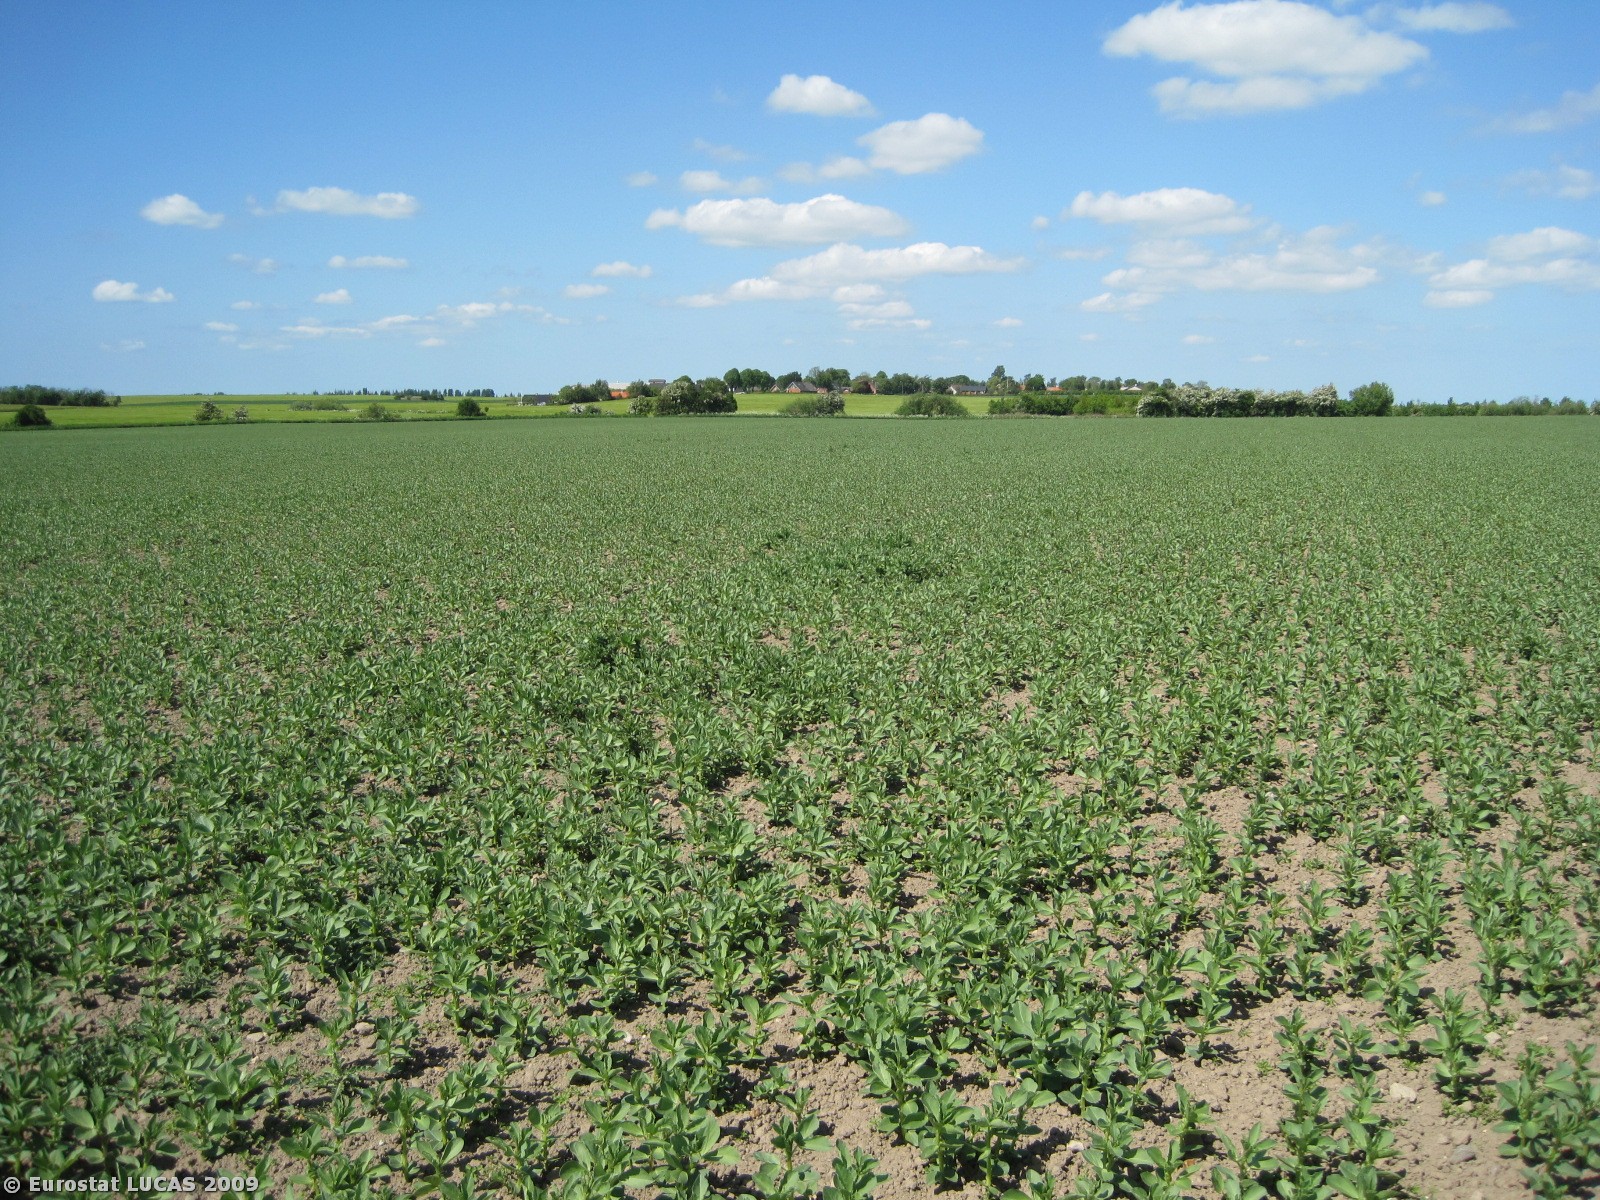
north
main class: Cropland
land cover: Dry pulses
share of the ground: 25 - 50 %
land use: Agriculture (excluding fallow land and kitchen gardens)
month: May
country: DK
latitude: 56.5110
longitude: 10.2759
